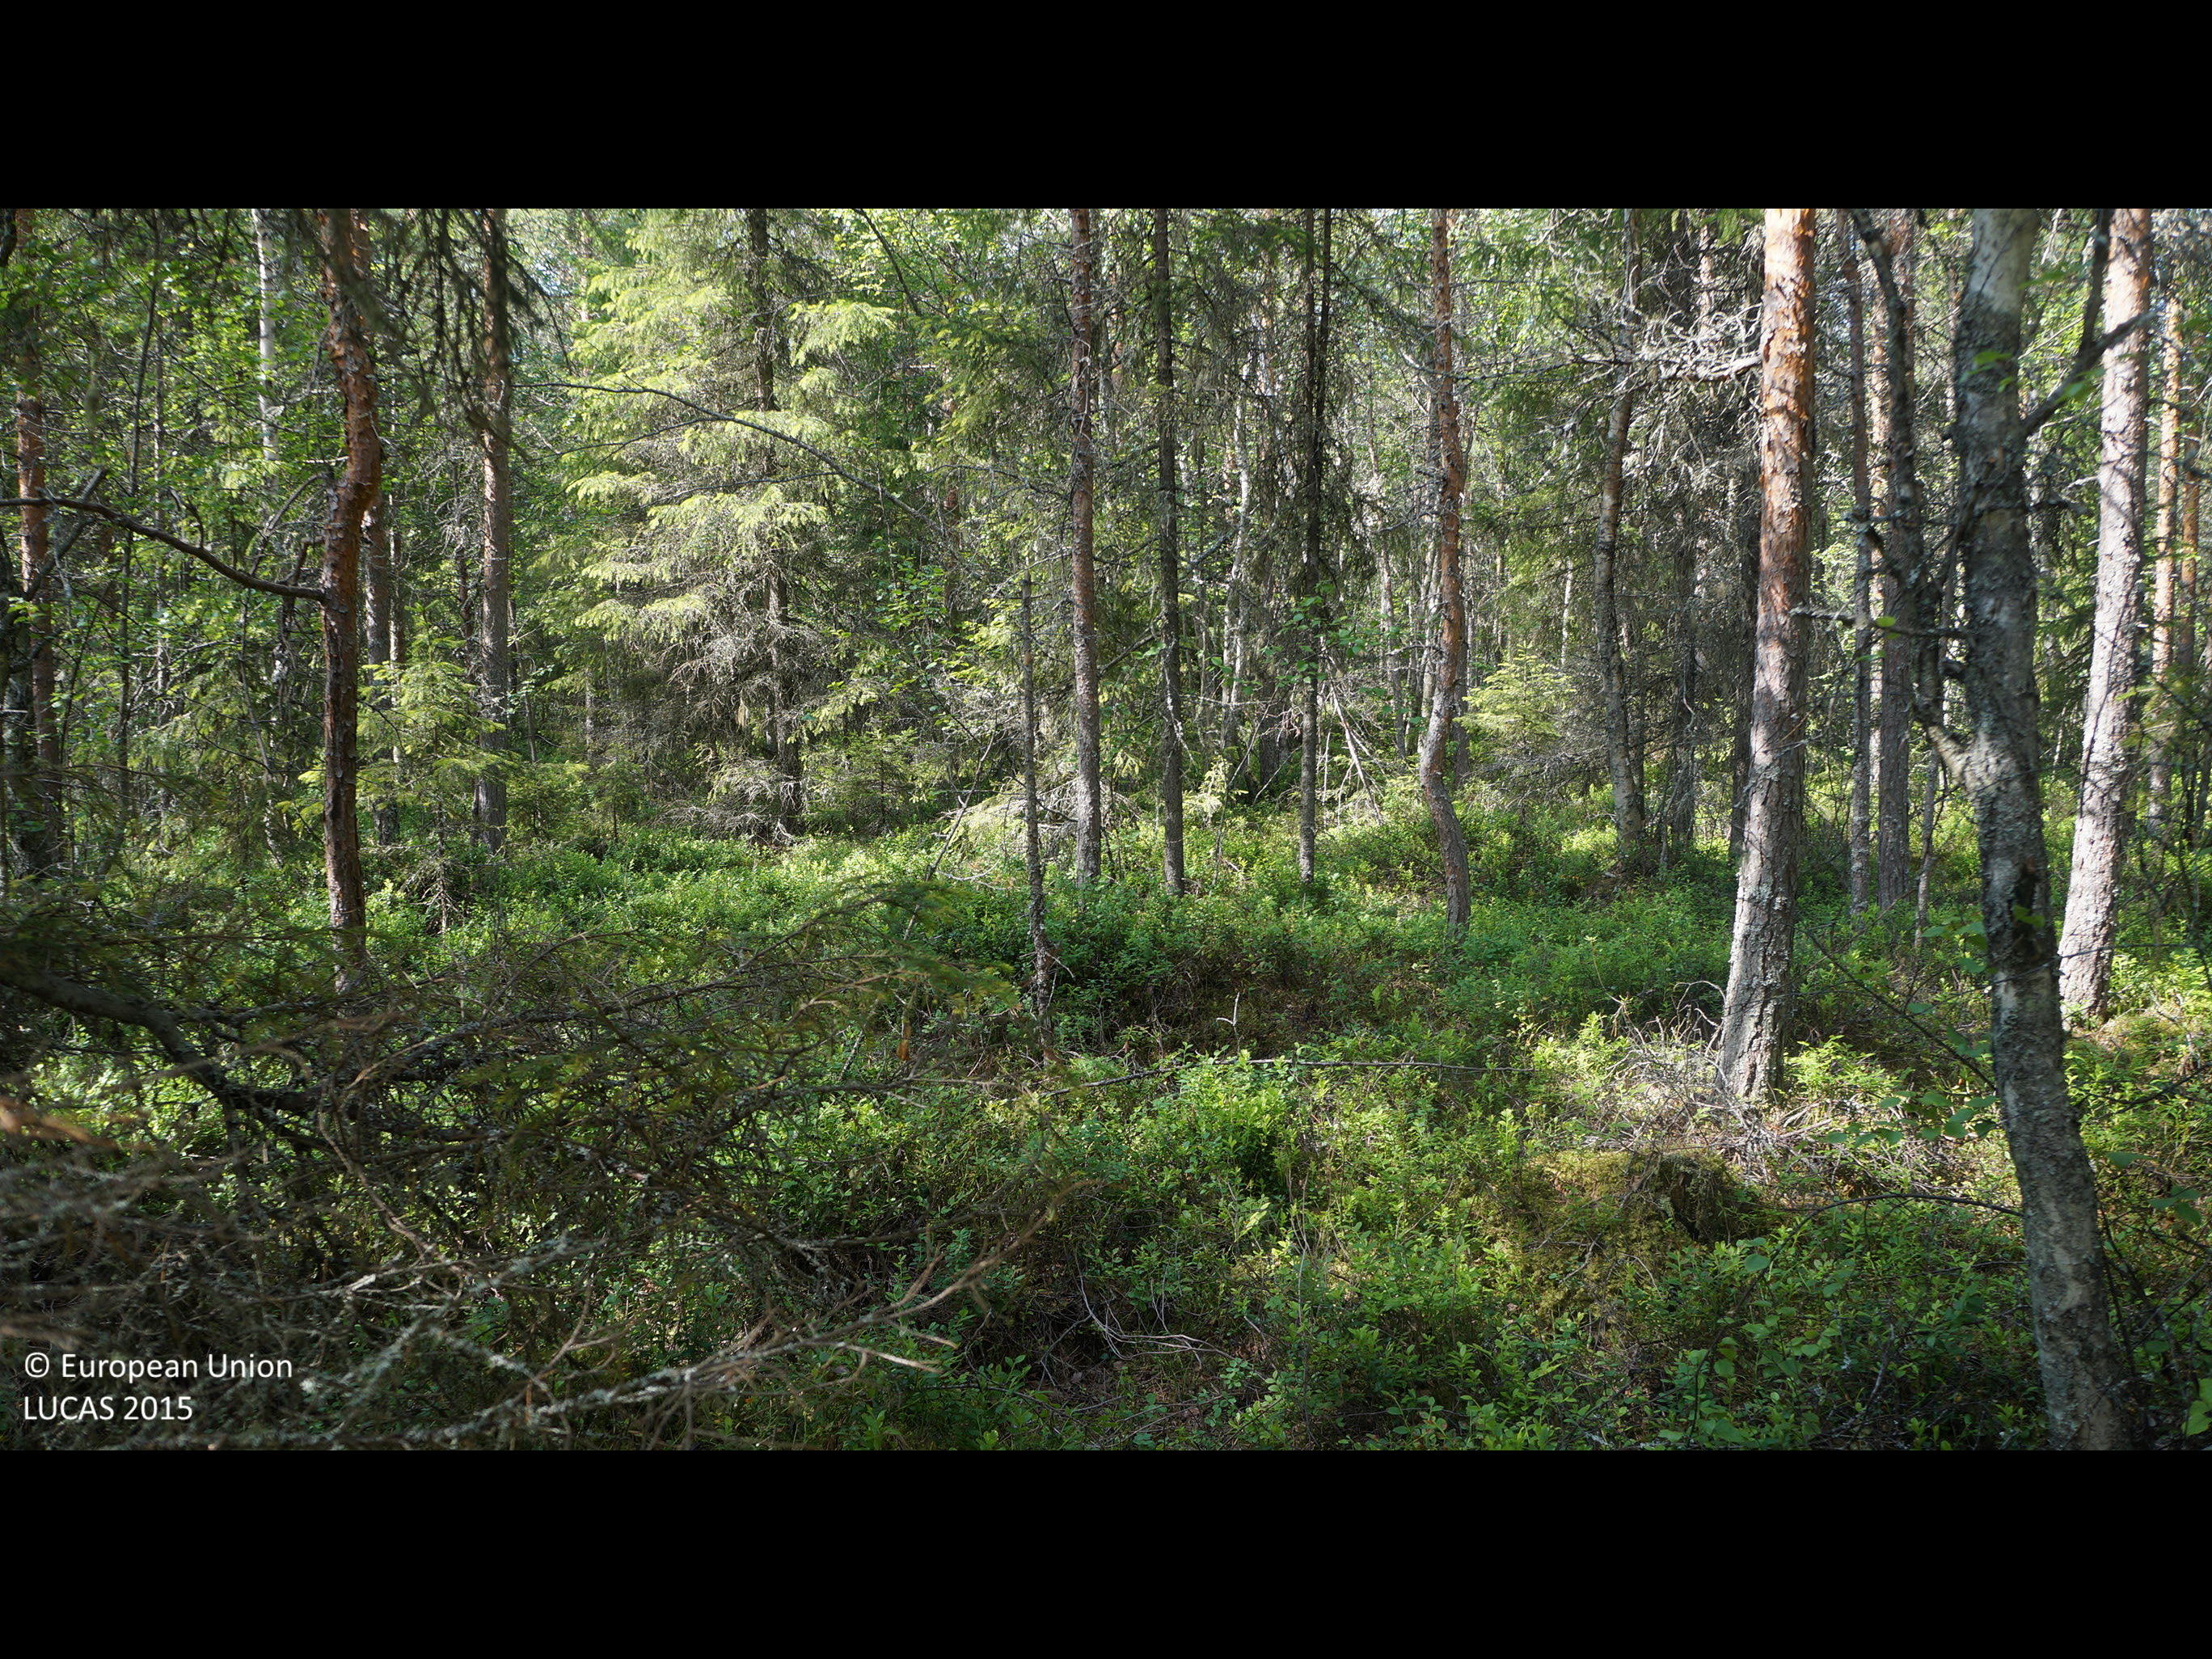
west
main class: Woodland
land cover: Pine dominated coniferous woodland
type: boreal forest
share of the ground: 50 - 75 %
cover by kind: coniferous forest trees 60 %, shrubs 25 %, broadleaved forest trees 10 %, lichens and mosses 5 %
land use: Forestry
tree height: > 5 m
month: July
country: FI
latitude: 64.5657
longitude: 24.4033
